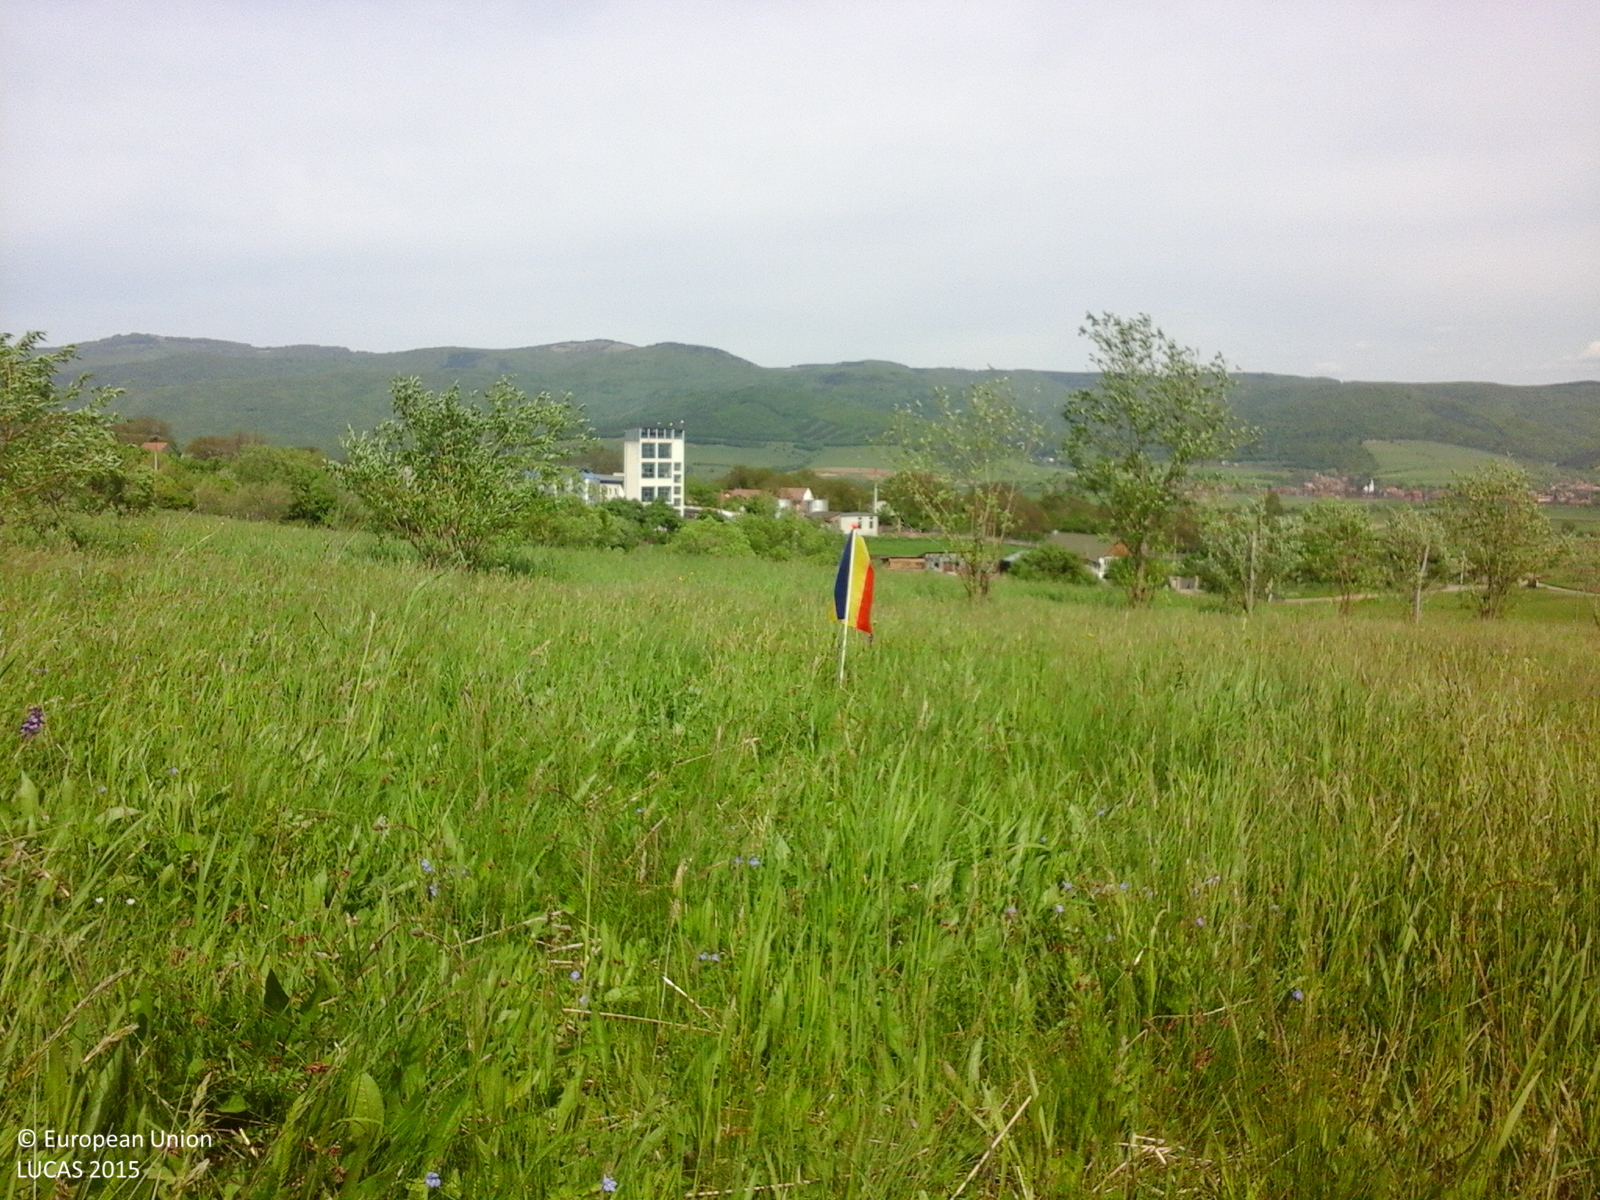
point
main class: Grassland
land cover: Grassland without tree/shrub cover
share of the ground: > 75 %
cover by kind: herbaceous plants 100 %
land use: Agriculture (excluding fallow land and kitchen gardens)
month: May
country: RO
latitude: 45.9541
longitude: 25.8135
